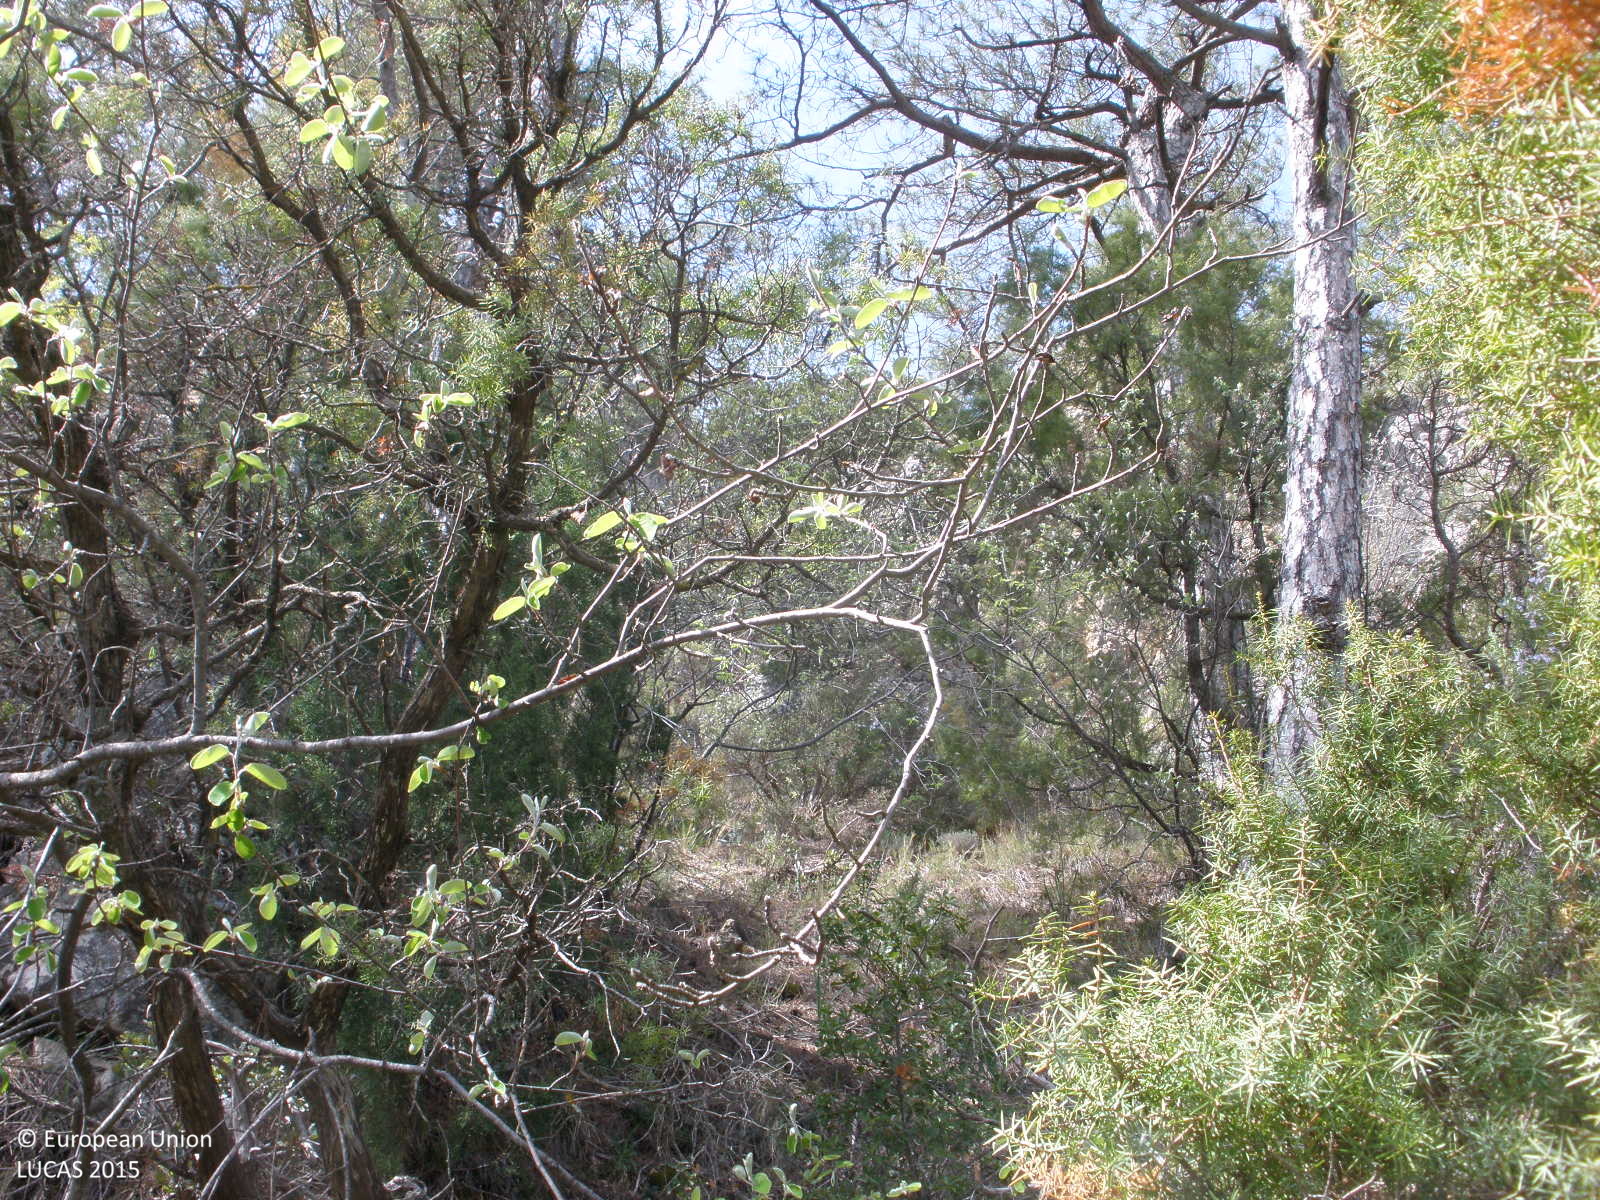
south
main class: Woodland
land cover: Pine dominated coniferous woodland
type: coniferous forest of the mediterranean region
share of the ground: > 75 %
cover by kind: coniferous forest trees 70 %, shrubs 30 %
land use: Semi-natural and natural areas not in use
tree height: > 5 m
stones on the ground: > 50 %
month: April
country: ES
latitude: 40.0461
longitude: -1.1782
